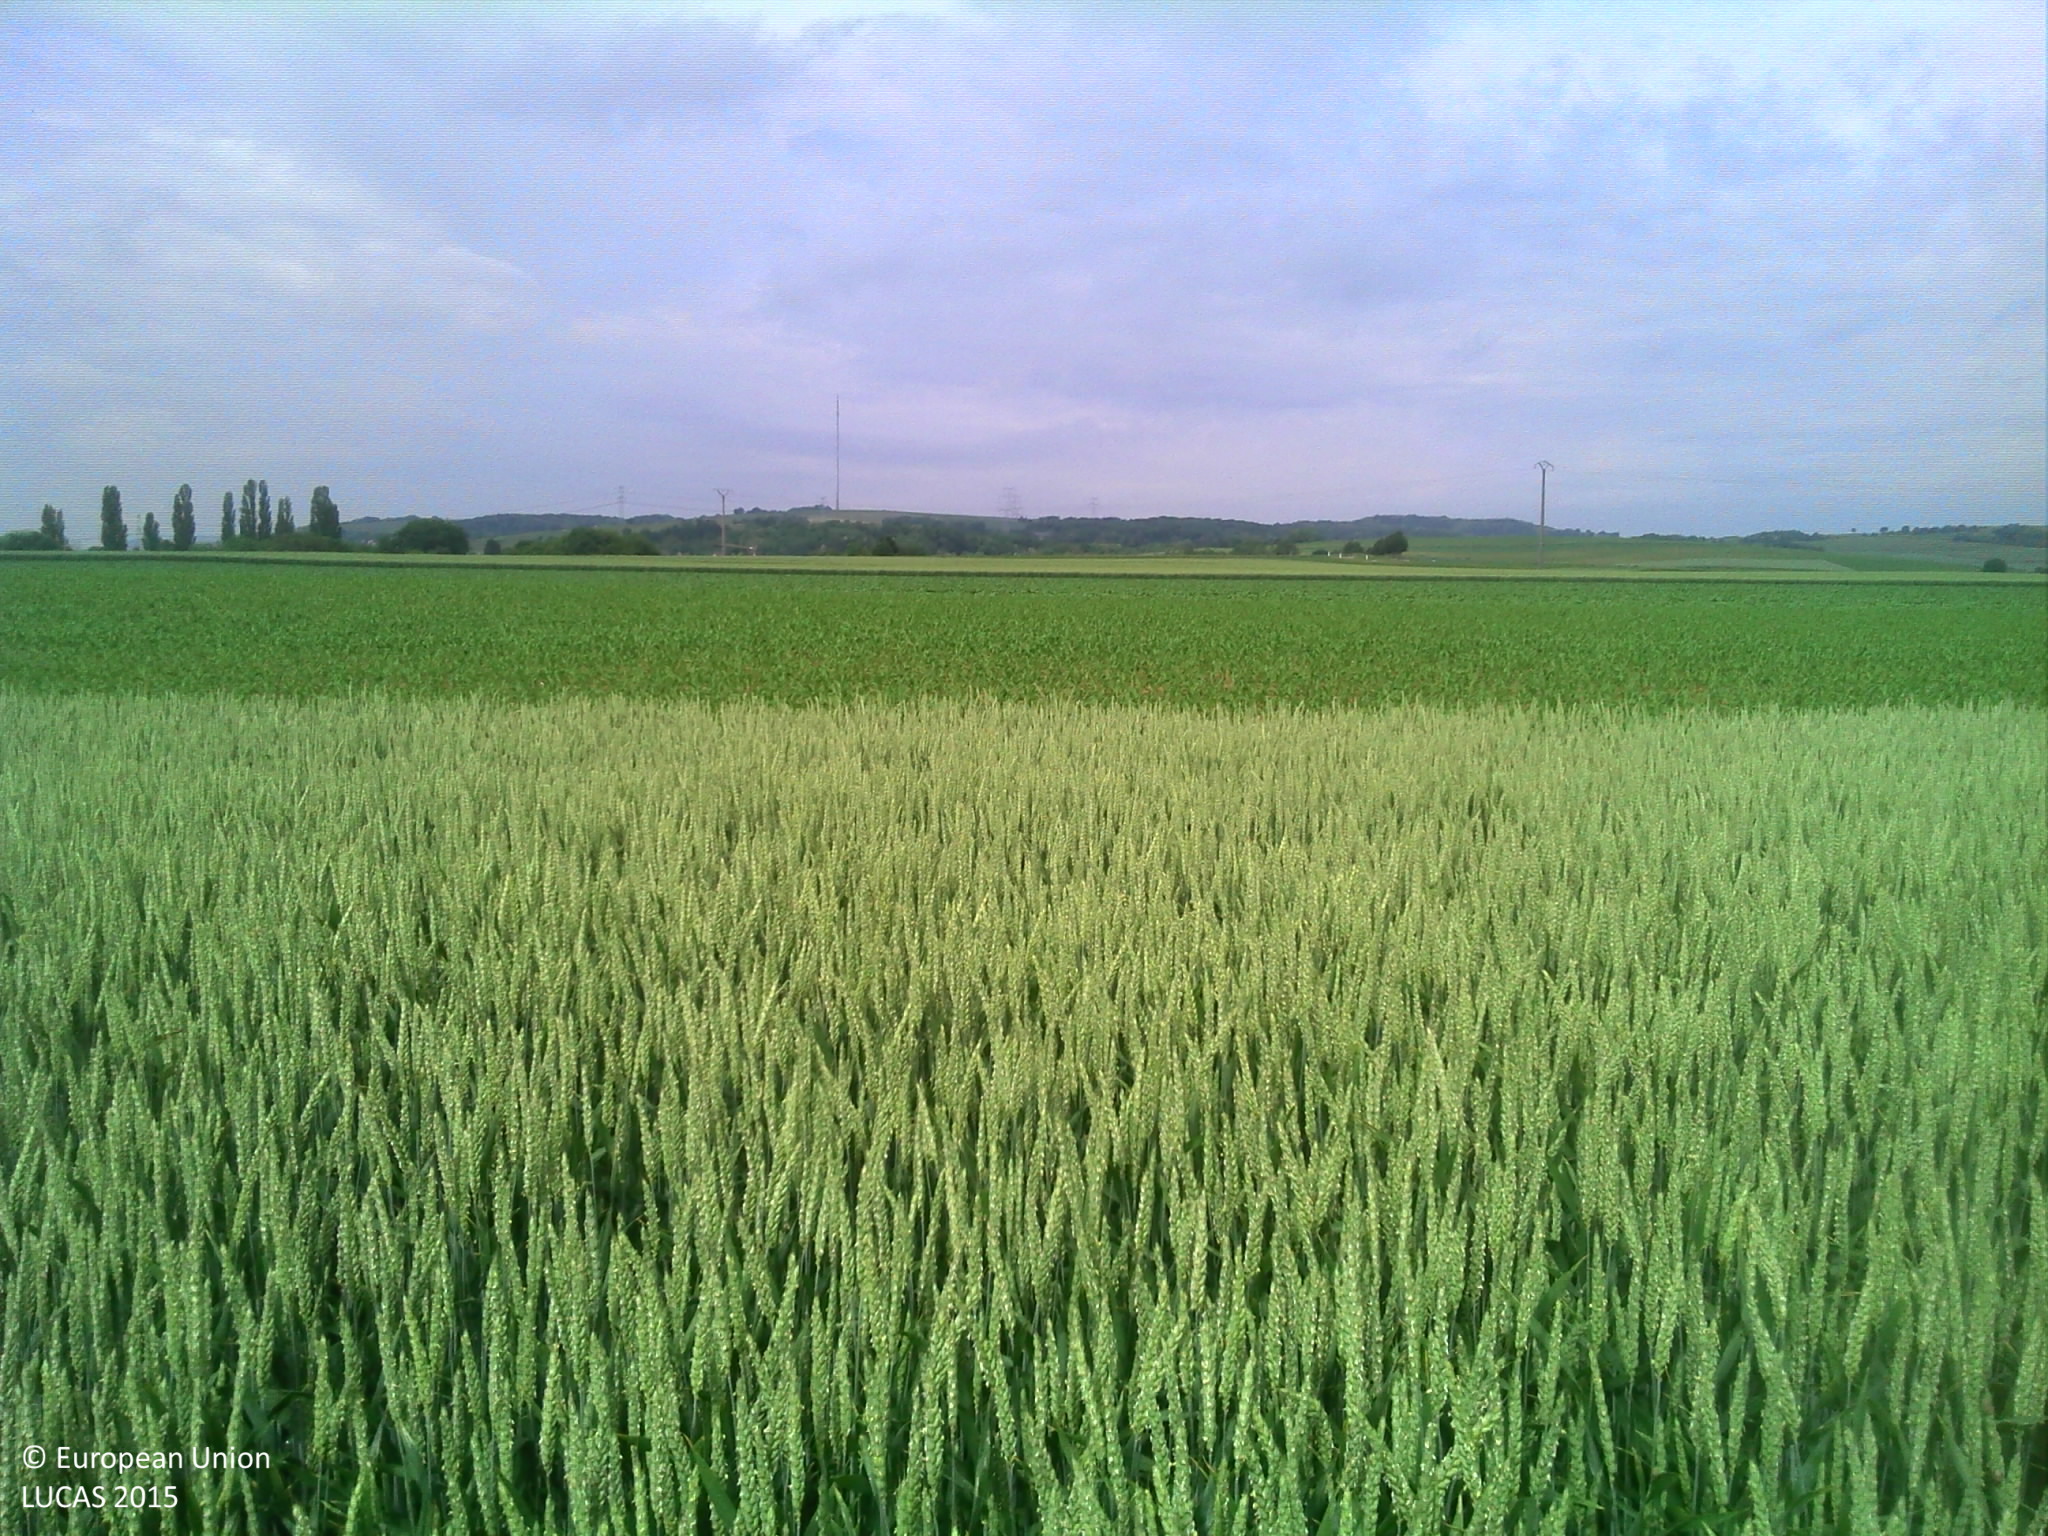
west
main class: Cropland
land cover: Common wheat
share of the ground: > 75 %
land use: Agriculture (excluding fallow land and kitchen gardens)
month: May
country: FR
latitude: 48.6462
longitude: 7.5441
